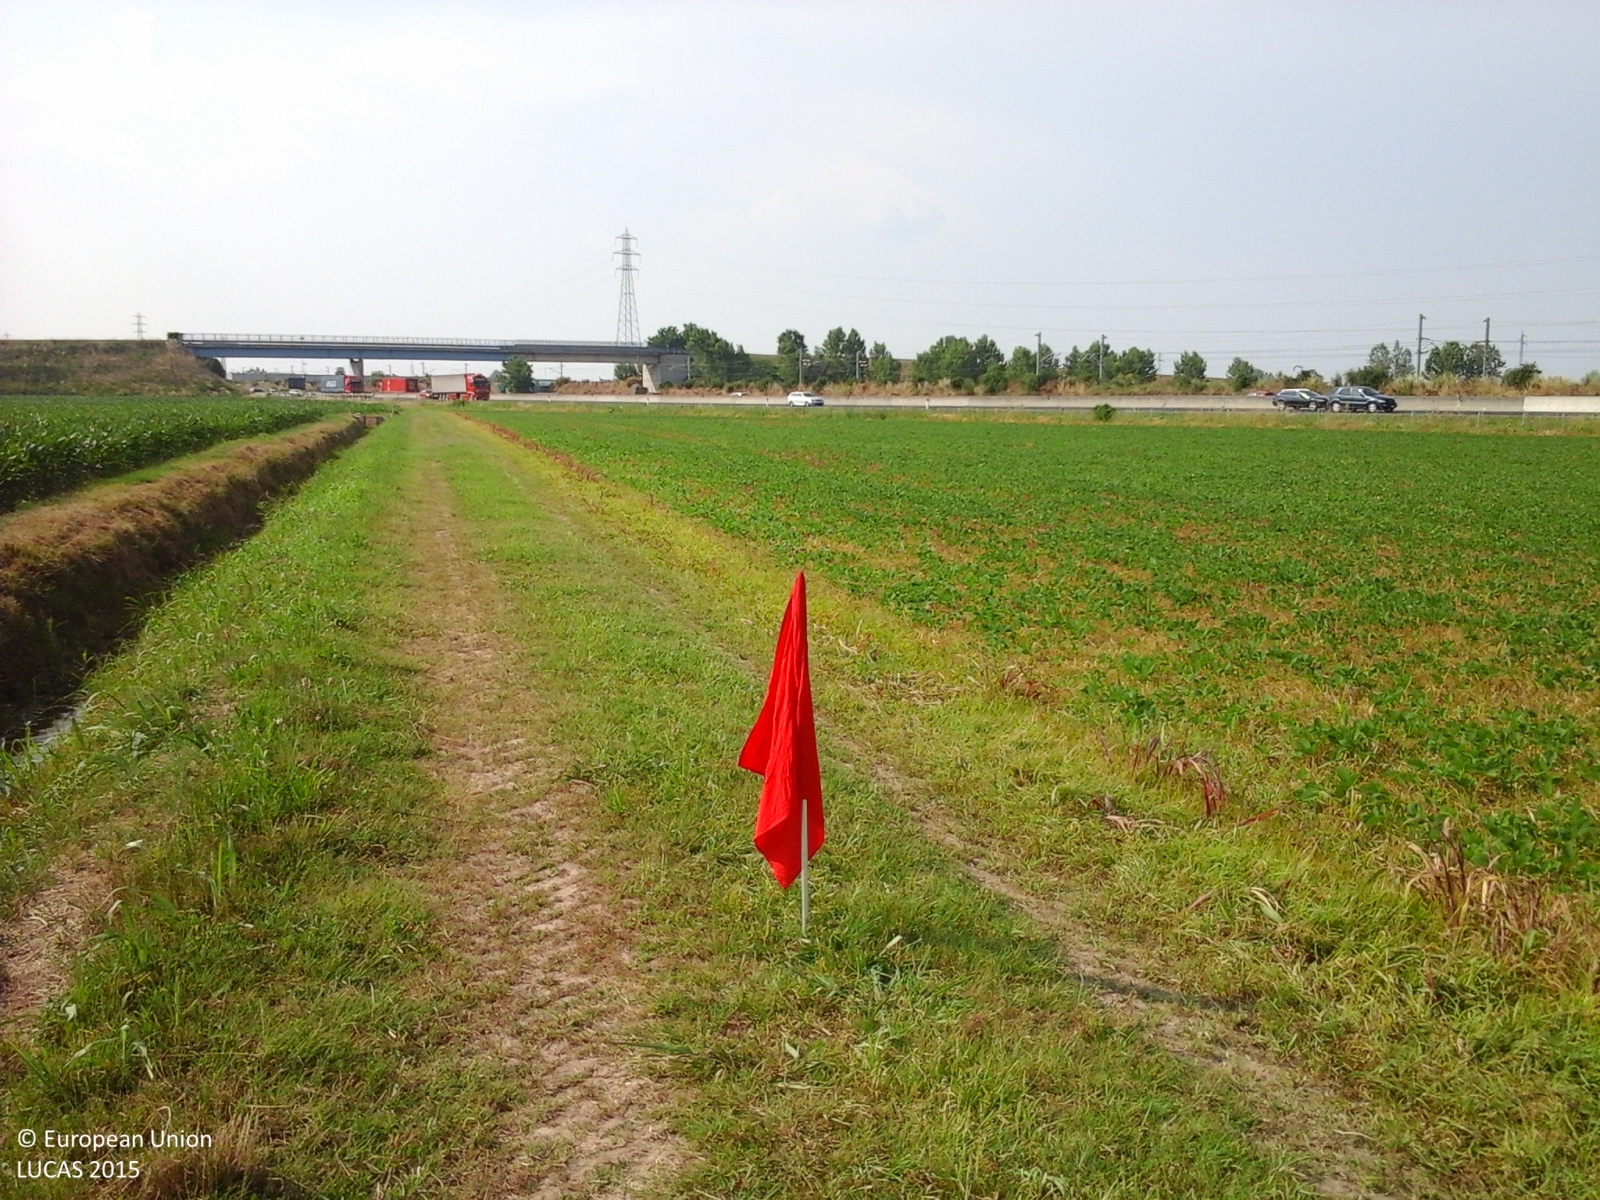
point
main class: Artificial land
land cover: Non built-up linear features
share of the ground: > 75 %
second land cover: Grassland without tree/shrub cover
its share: > 75 %
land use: Road transport
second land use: Agriculture (excluding fallow land and kitchen gardens)
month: June
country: IT
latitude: 45.1612
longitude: 9.6064
